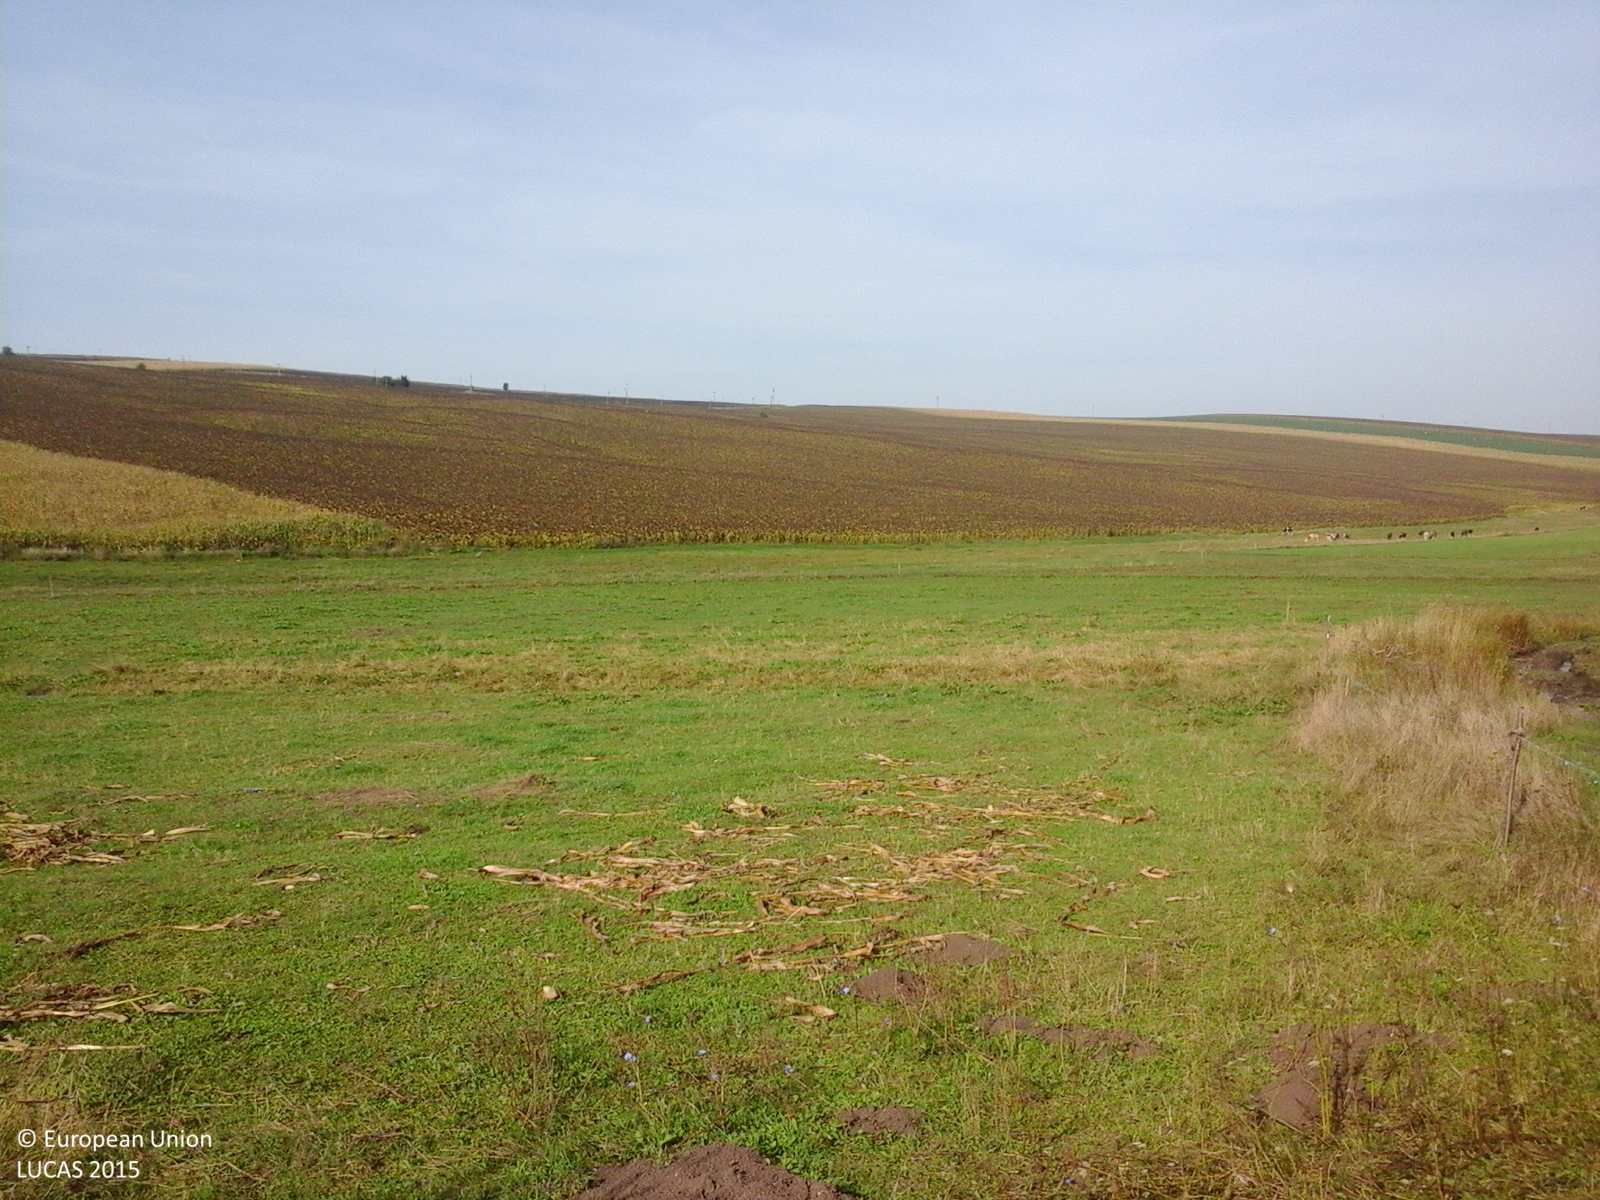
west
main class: Grassland
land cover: Grassland without tree/shrub cover
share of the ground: > 75 %
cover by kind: herbaceous plants 100 %
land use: Agriculture (excluding fallow land and kitchen gardens)
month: September
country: RO
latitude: 46.6523
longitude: 23.8340
